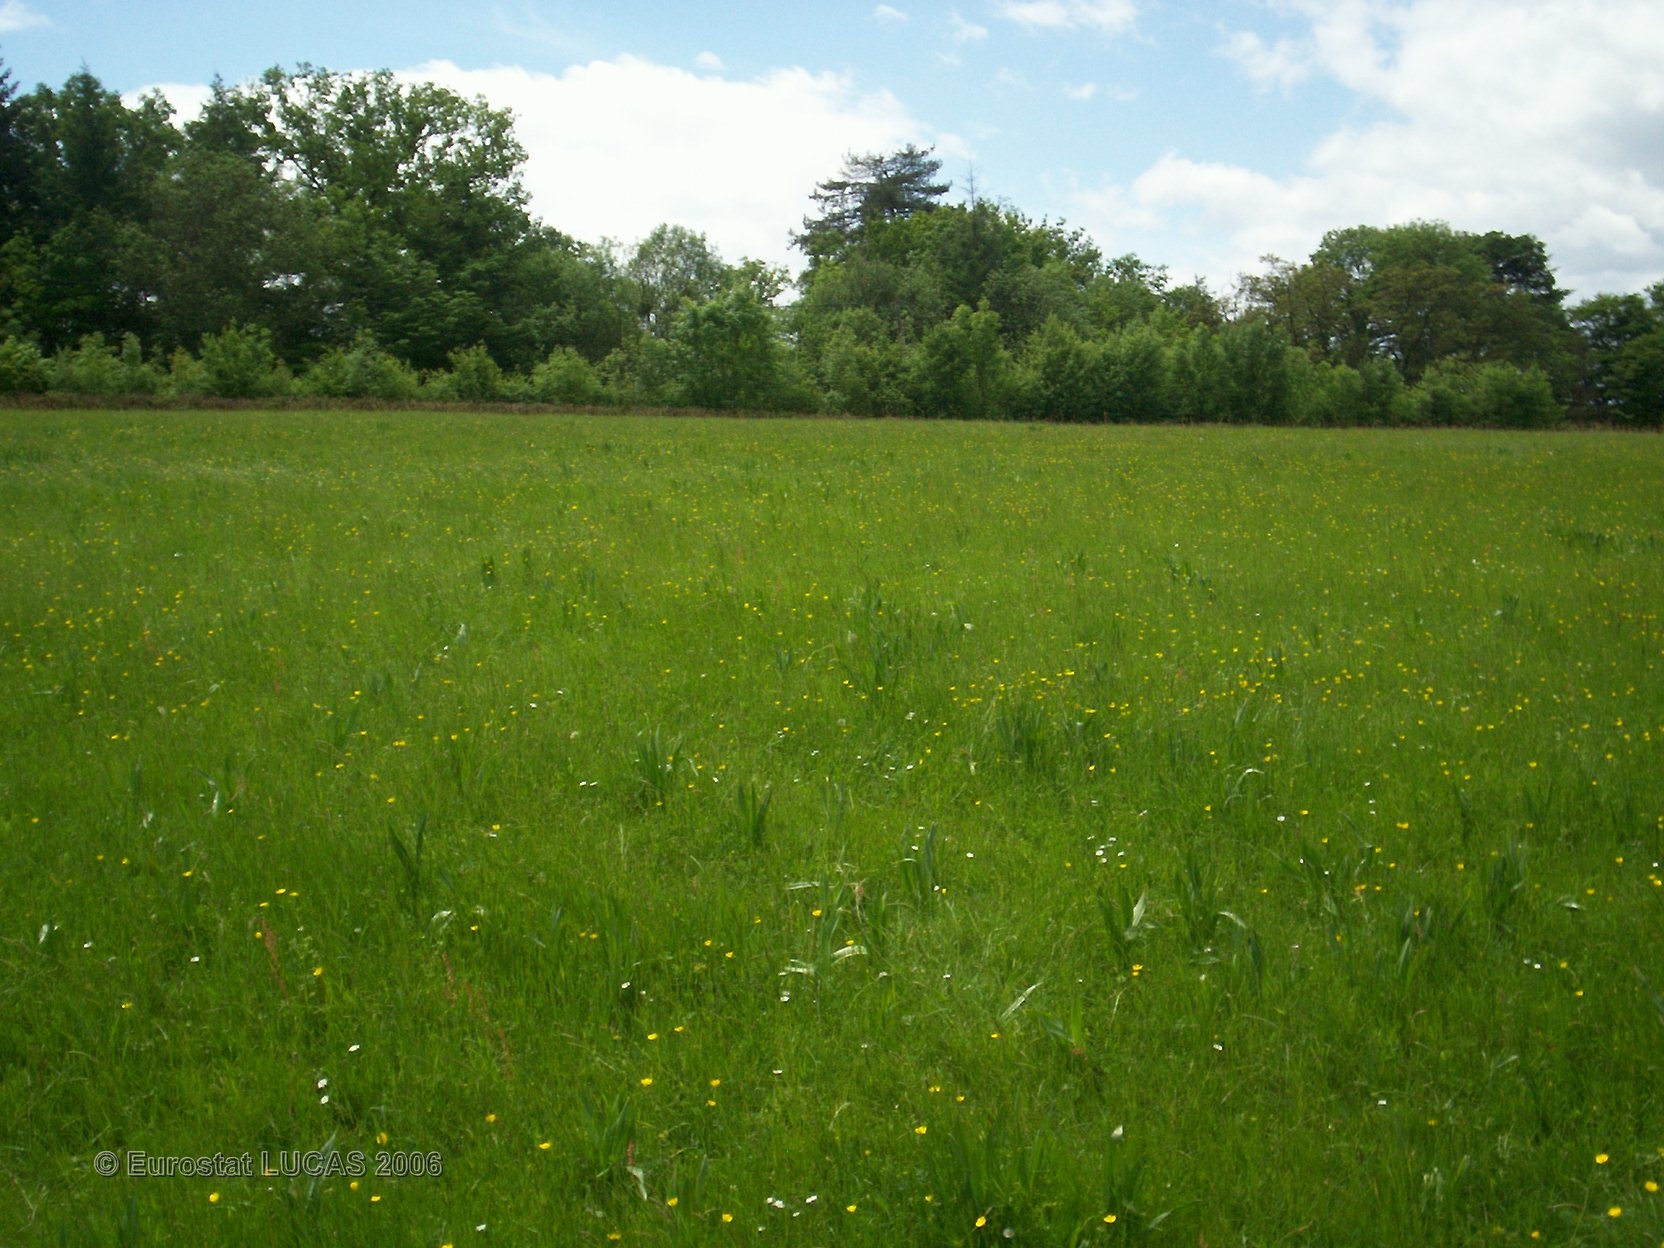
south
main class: Grassland
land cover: Grassland without tree/shrub cover
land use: Agriculture (excluding fallow land and kitchen gardens)
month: May
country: FR
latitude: 47.0445
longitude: 4.5907
